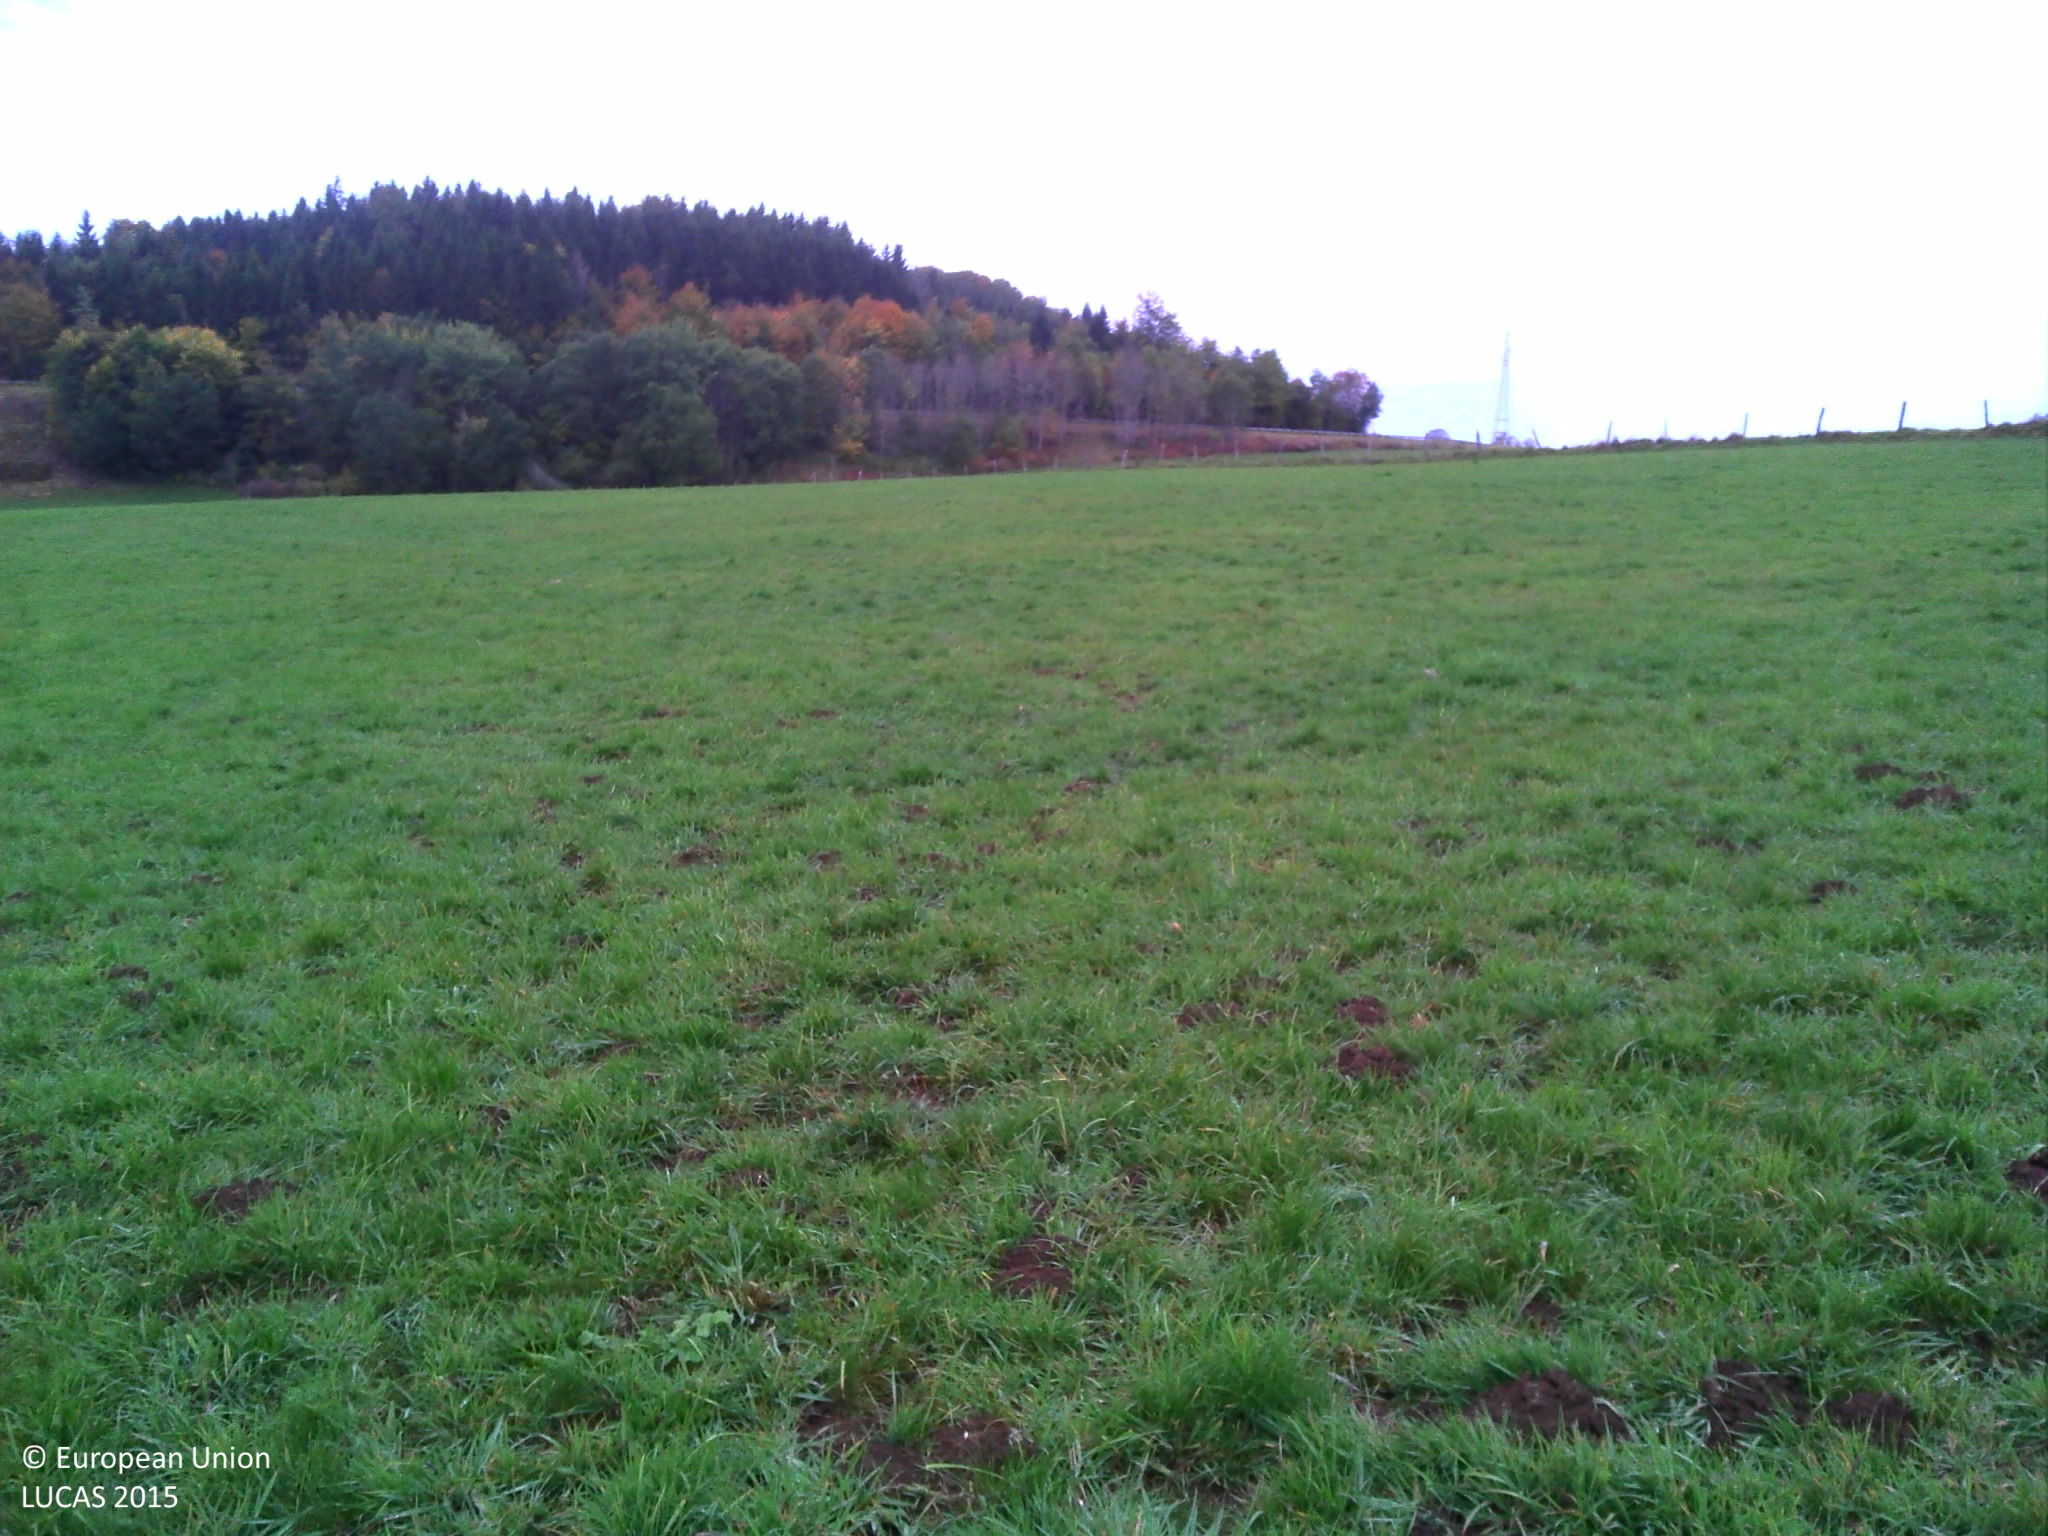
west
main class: Grassland
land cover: Grassland without tree/shrub cover
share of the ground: > 75 %
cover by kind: herbaceous plants 100 %
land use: Agriculture (excluding fallow land and kitchen gardens)
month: October
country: FR
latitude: 46.9357
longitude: 6.2850
